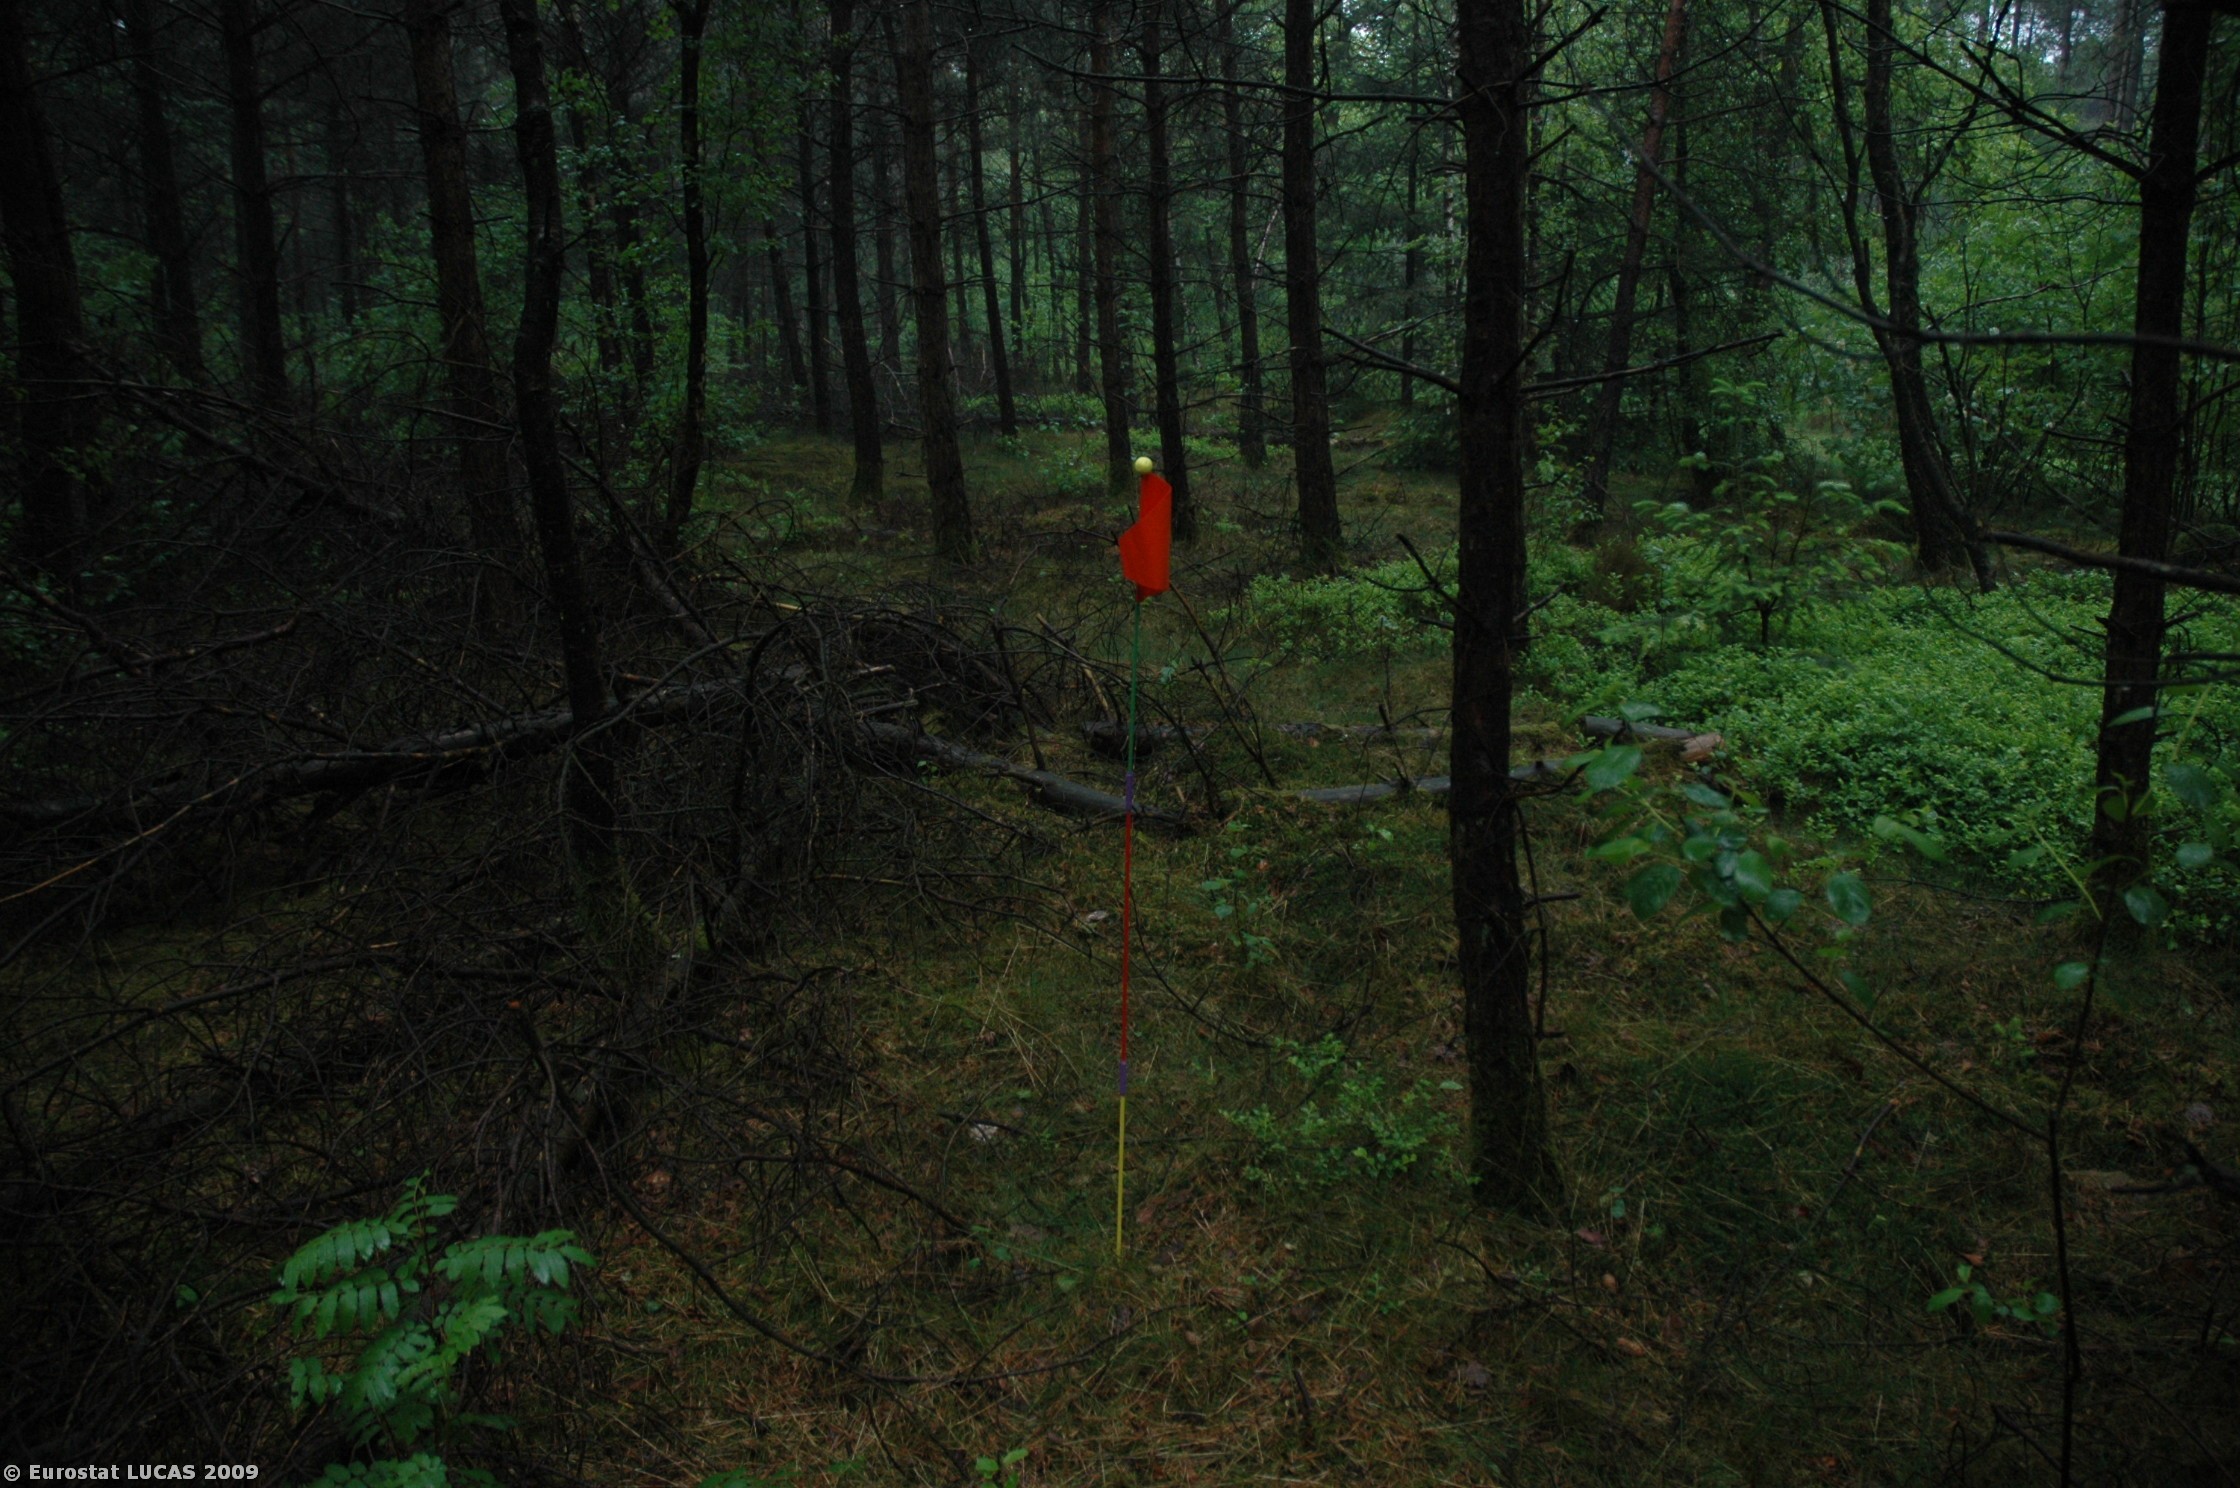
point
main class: Woodland
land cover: Mixed woodland
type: hemiboreal forest and nemoral coniferous forest and mixed broadleaved-coniferous forest
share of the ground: > 75 %
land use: Amenities, museums, leisure
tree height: > 5 m
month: May
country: NL
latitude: 52.1049
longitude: 5.3113
